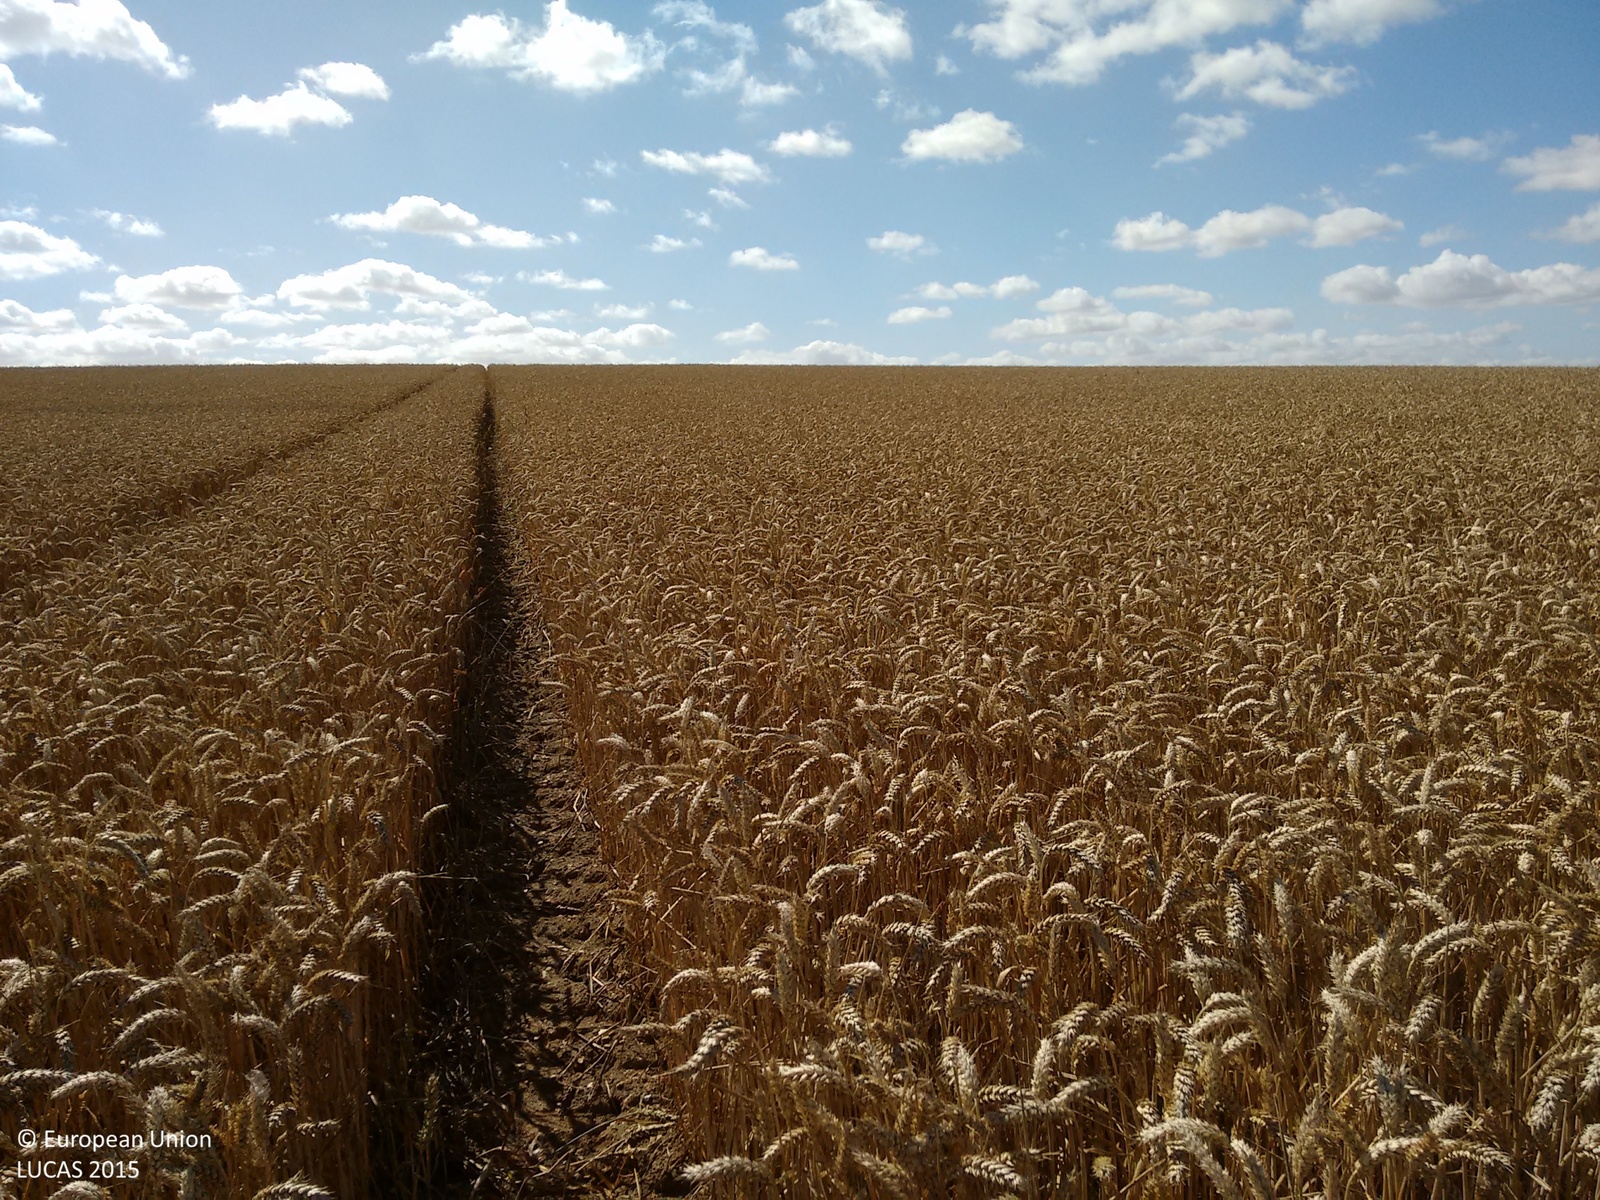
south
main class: Cropland
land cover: Common wheat
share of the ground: > 75 %
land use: Agriculture (excluding fallow land and kitchen gardens)
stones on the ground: 25 - 50 %
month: August
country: GB
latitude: 52.0947
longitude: 0.3811
